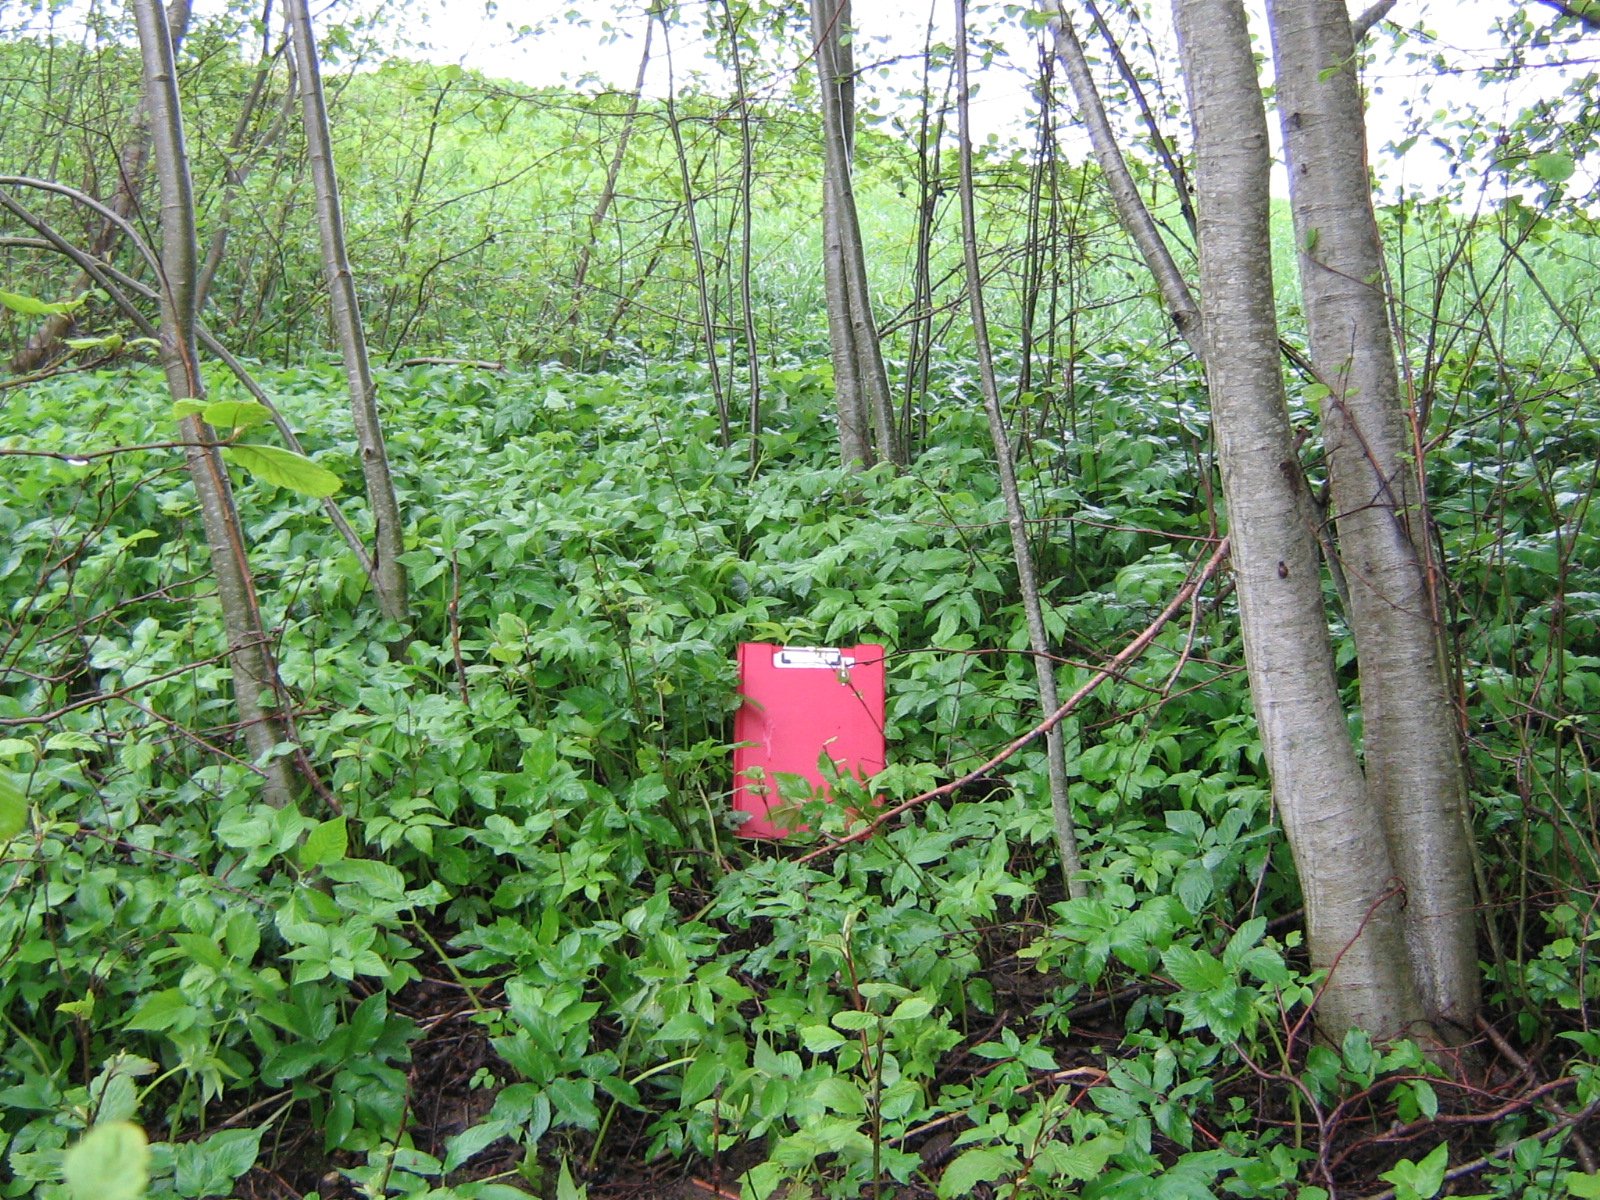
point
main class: Woodland
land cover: Broadleaved woodland
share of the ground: > 75 %
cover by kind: broadleaved forest trees 85 %, shrubs 15 %
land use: Semi-natural and natural areas not in use
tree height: > 5 m
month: May
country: LV
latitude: 57.2214
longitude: 25.9443
